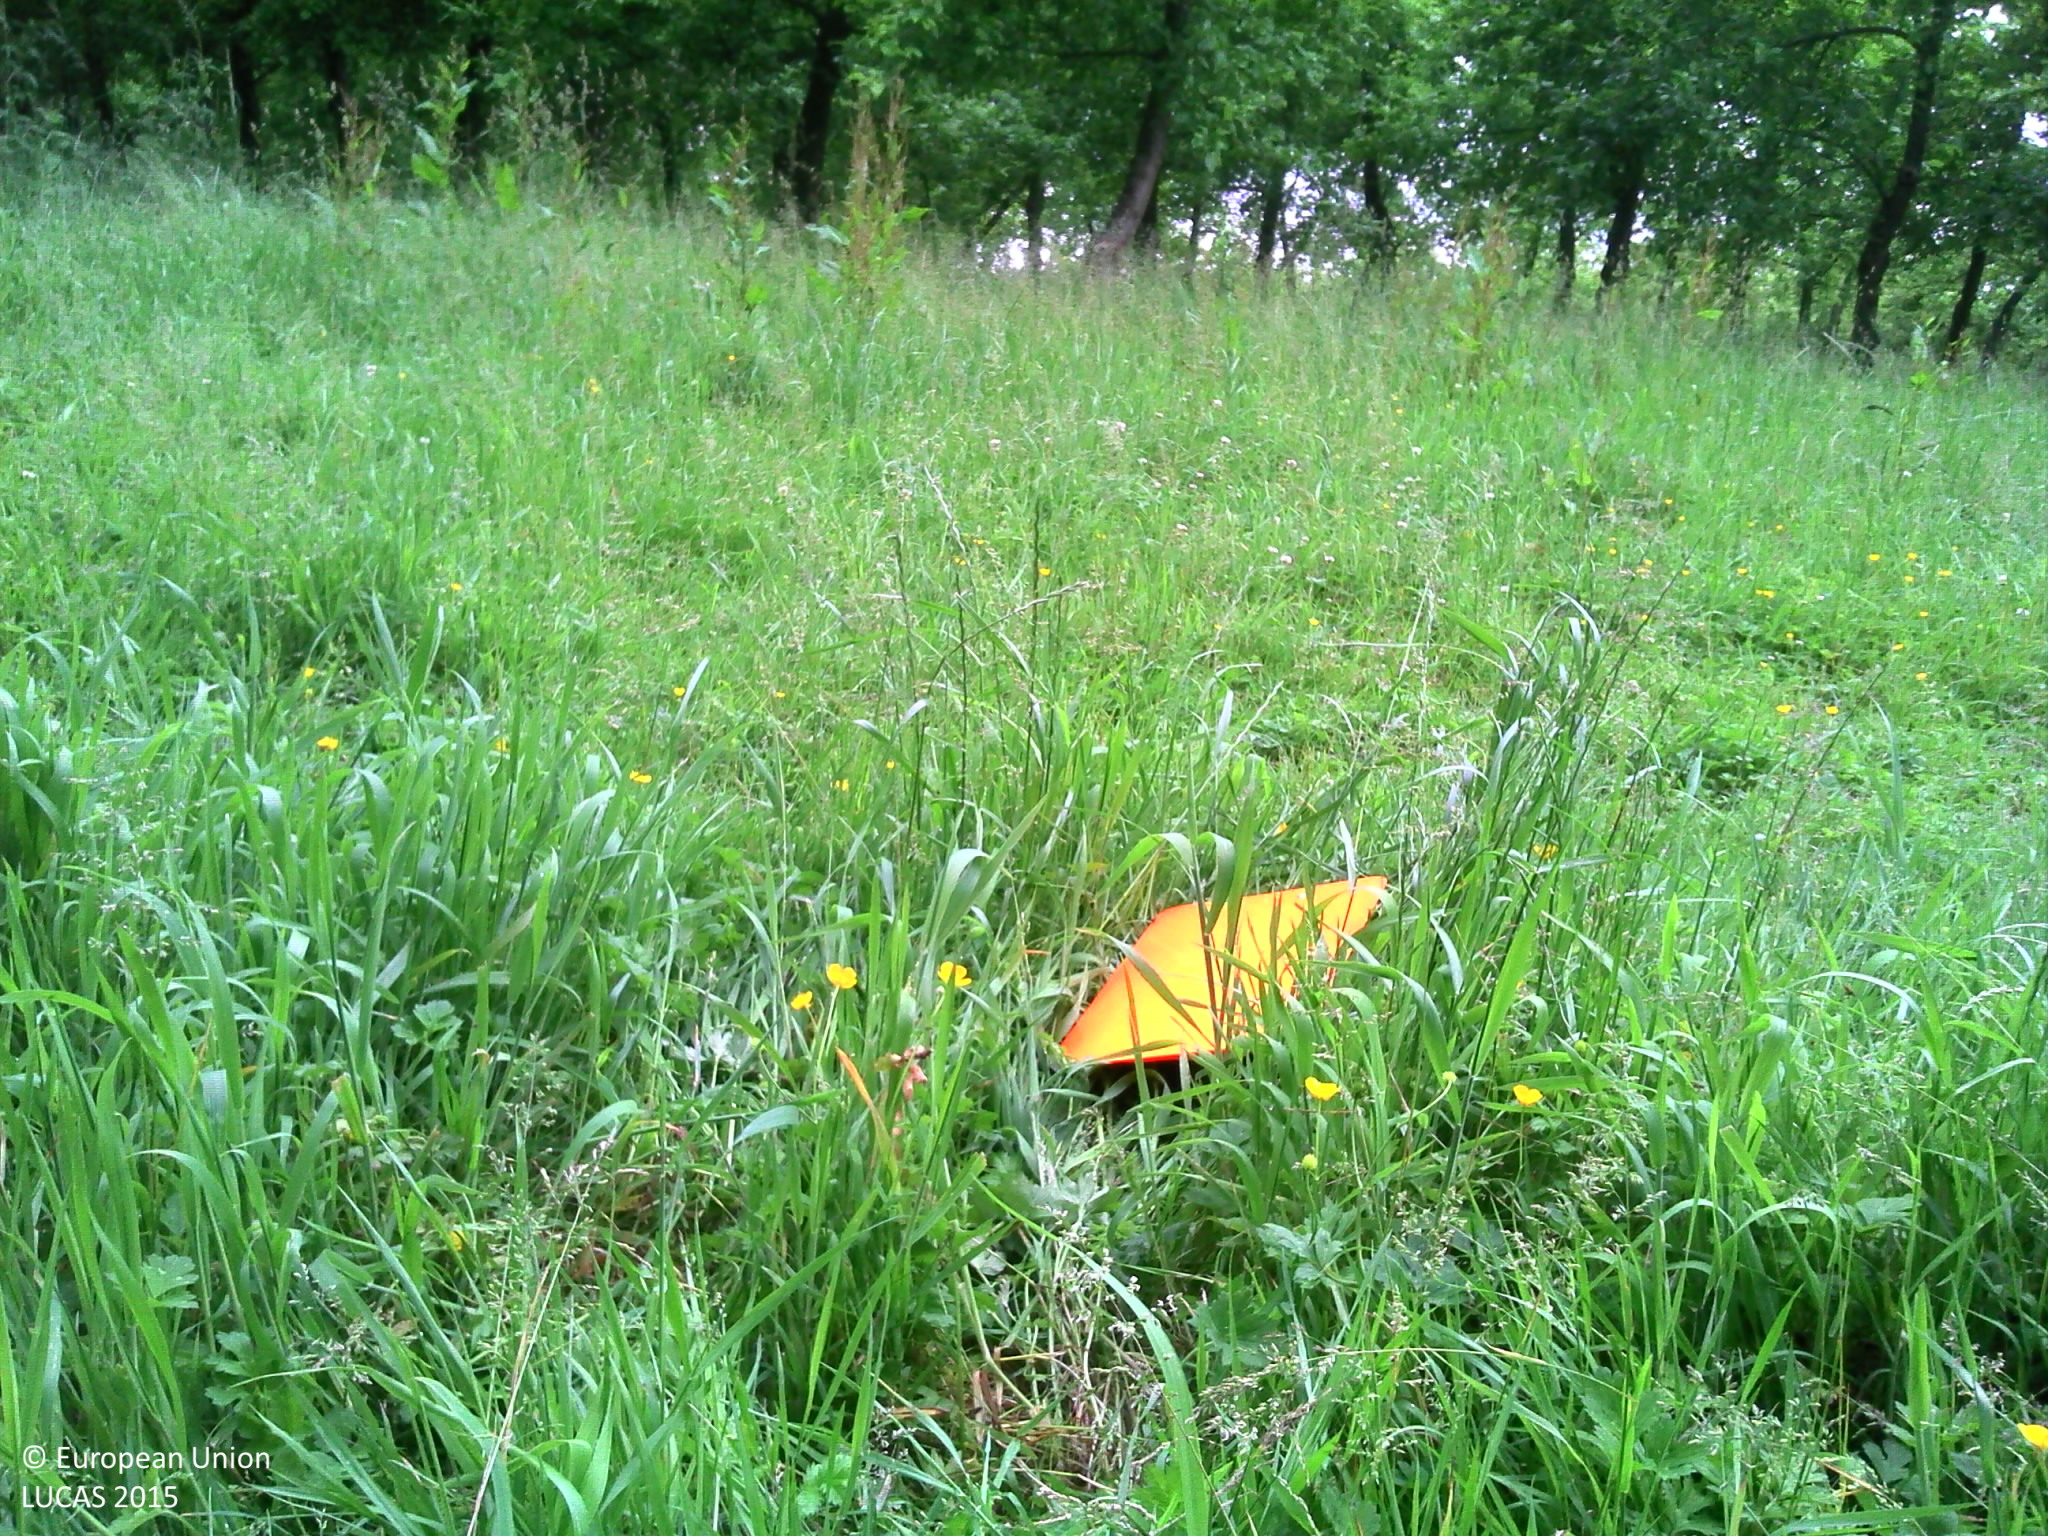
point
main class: Grassland
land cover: Grassland without tree/shrub cover
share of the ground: > 75 %
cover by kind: herbaceous plants 100 %
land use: Agriculture (excluding fallow land and kitchen gardens)
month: June
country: FR
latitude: 49.2500
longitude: -0.0466
